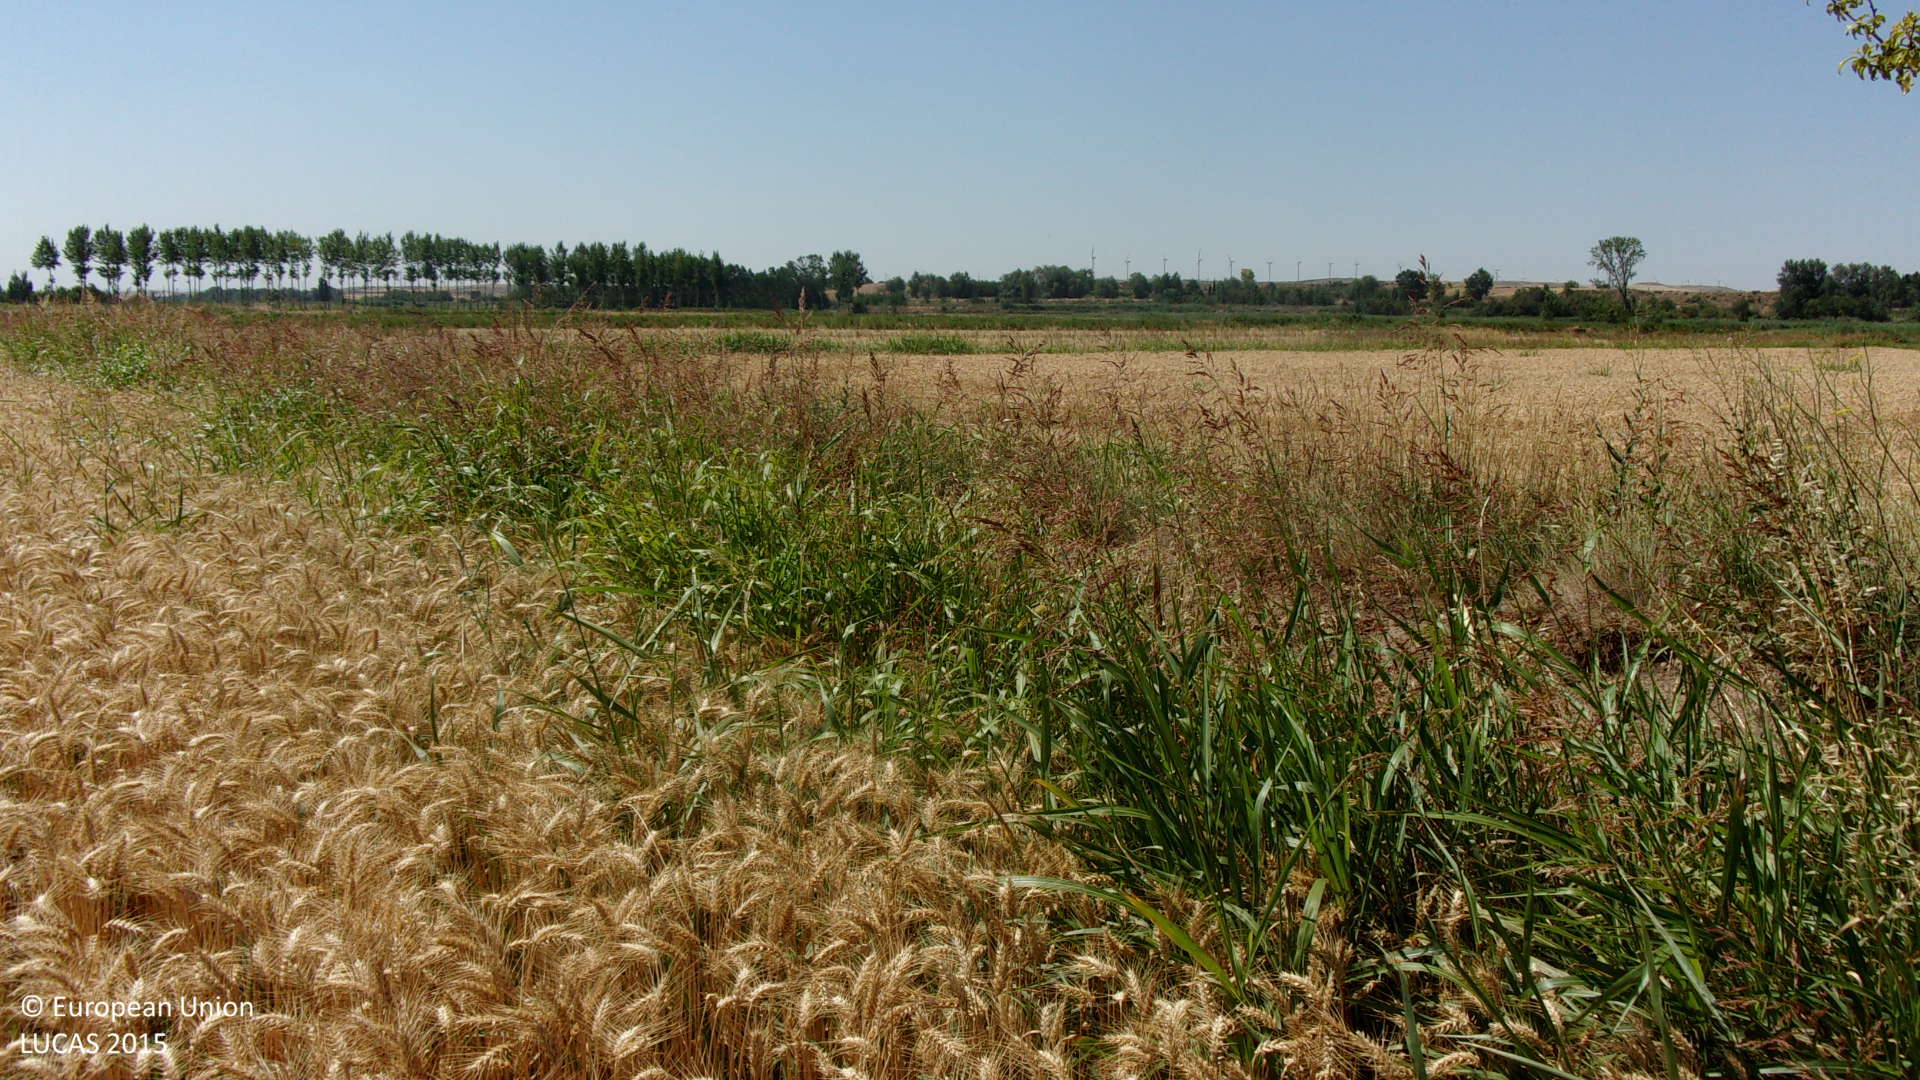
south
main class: Cropland
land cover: Common wheat
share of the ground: > 75 %
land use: Agriculture (excluding fallow land and kitchen gardens)
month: July
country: ES
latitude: 41.8389
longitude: -1.2865
